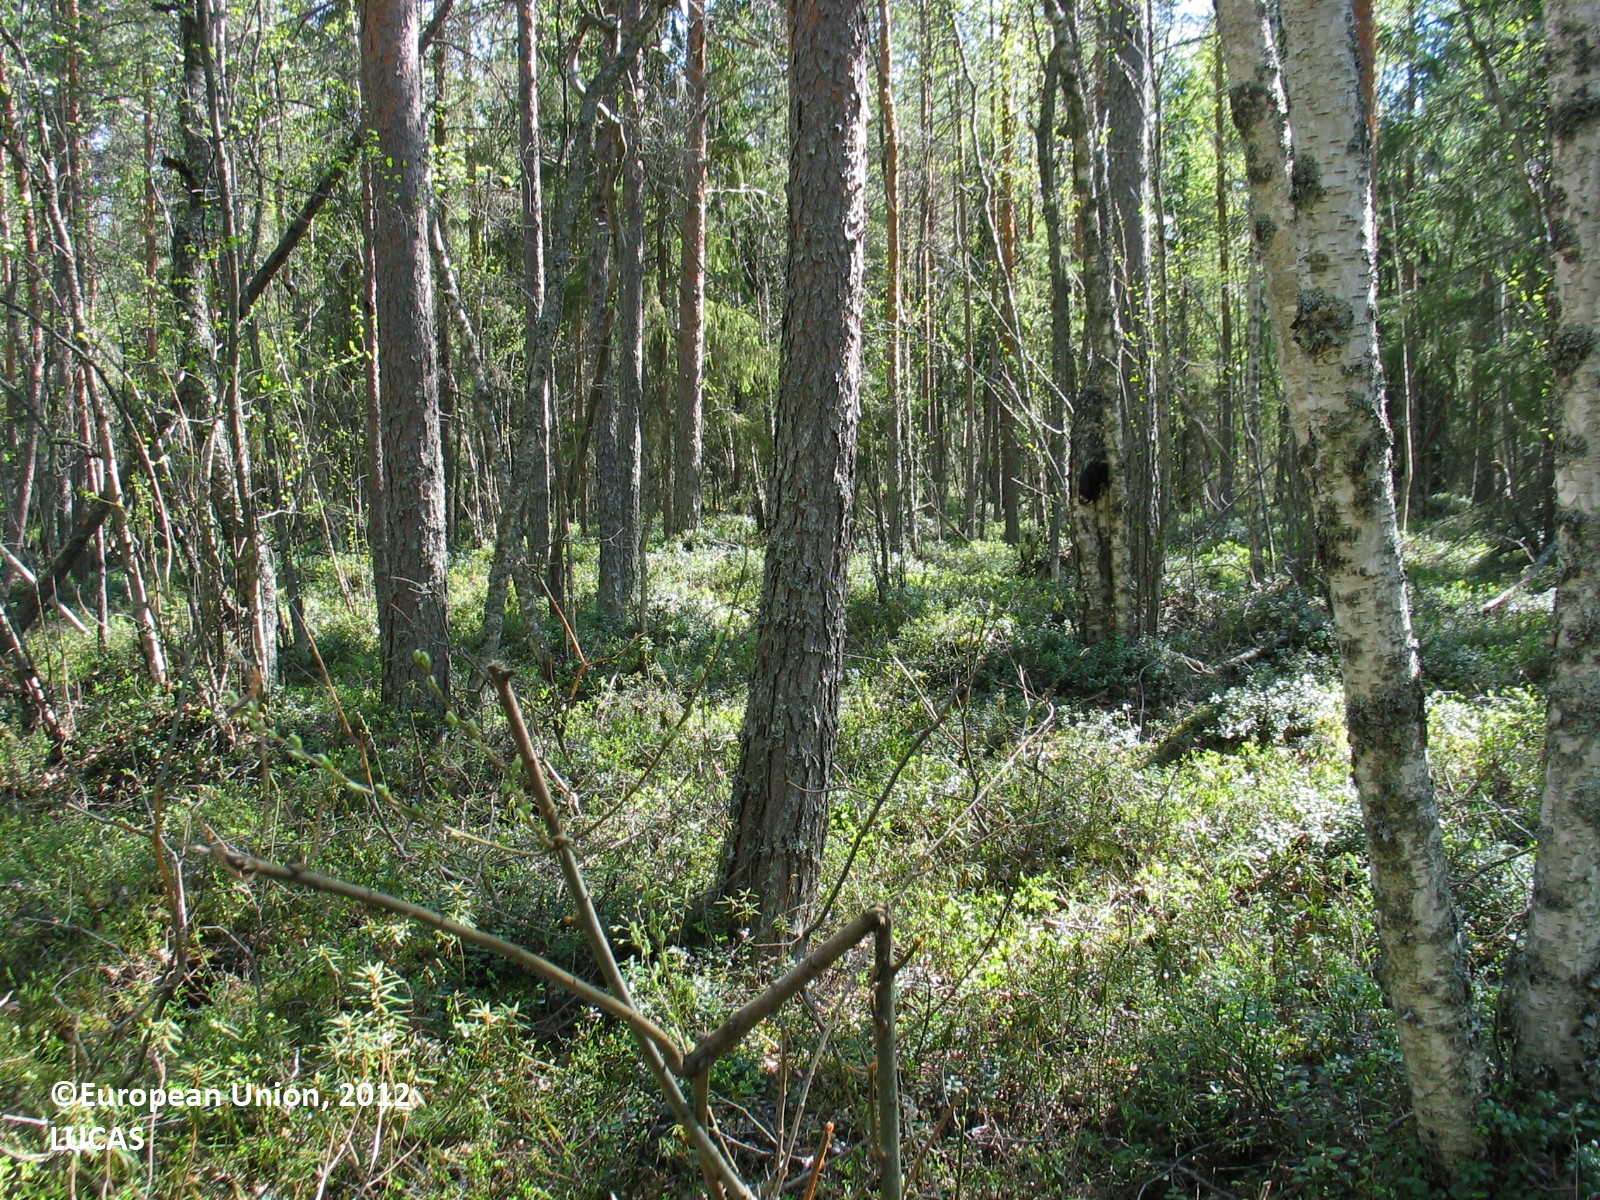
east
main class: Woodland
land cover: Other mixed woodland
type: mire and swamp forests
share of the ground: 50 - 75 %
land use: Forestry
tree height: > 5 m
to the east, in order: Other mixed woodland; Ditches and canals; Other mixed woodland; Ditches and canals; Other mixed woodland; Ditches and canals; Other mixed woodland; Ditches and canals; Other mixed woodland
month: May
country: FI
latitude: 64.9654
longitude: 25.2647
